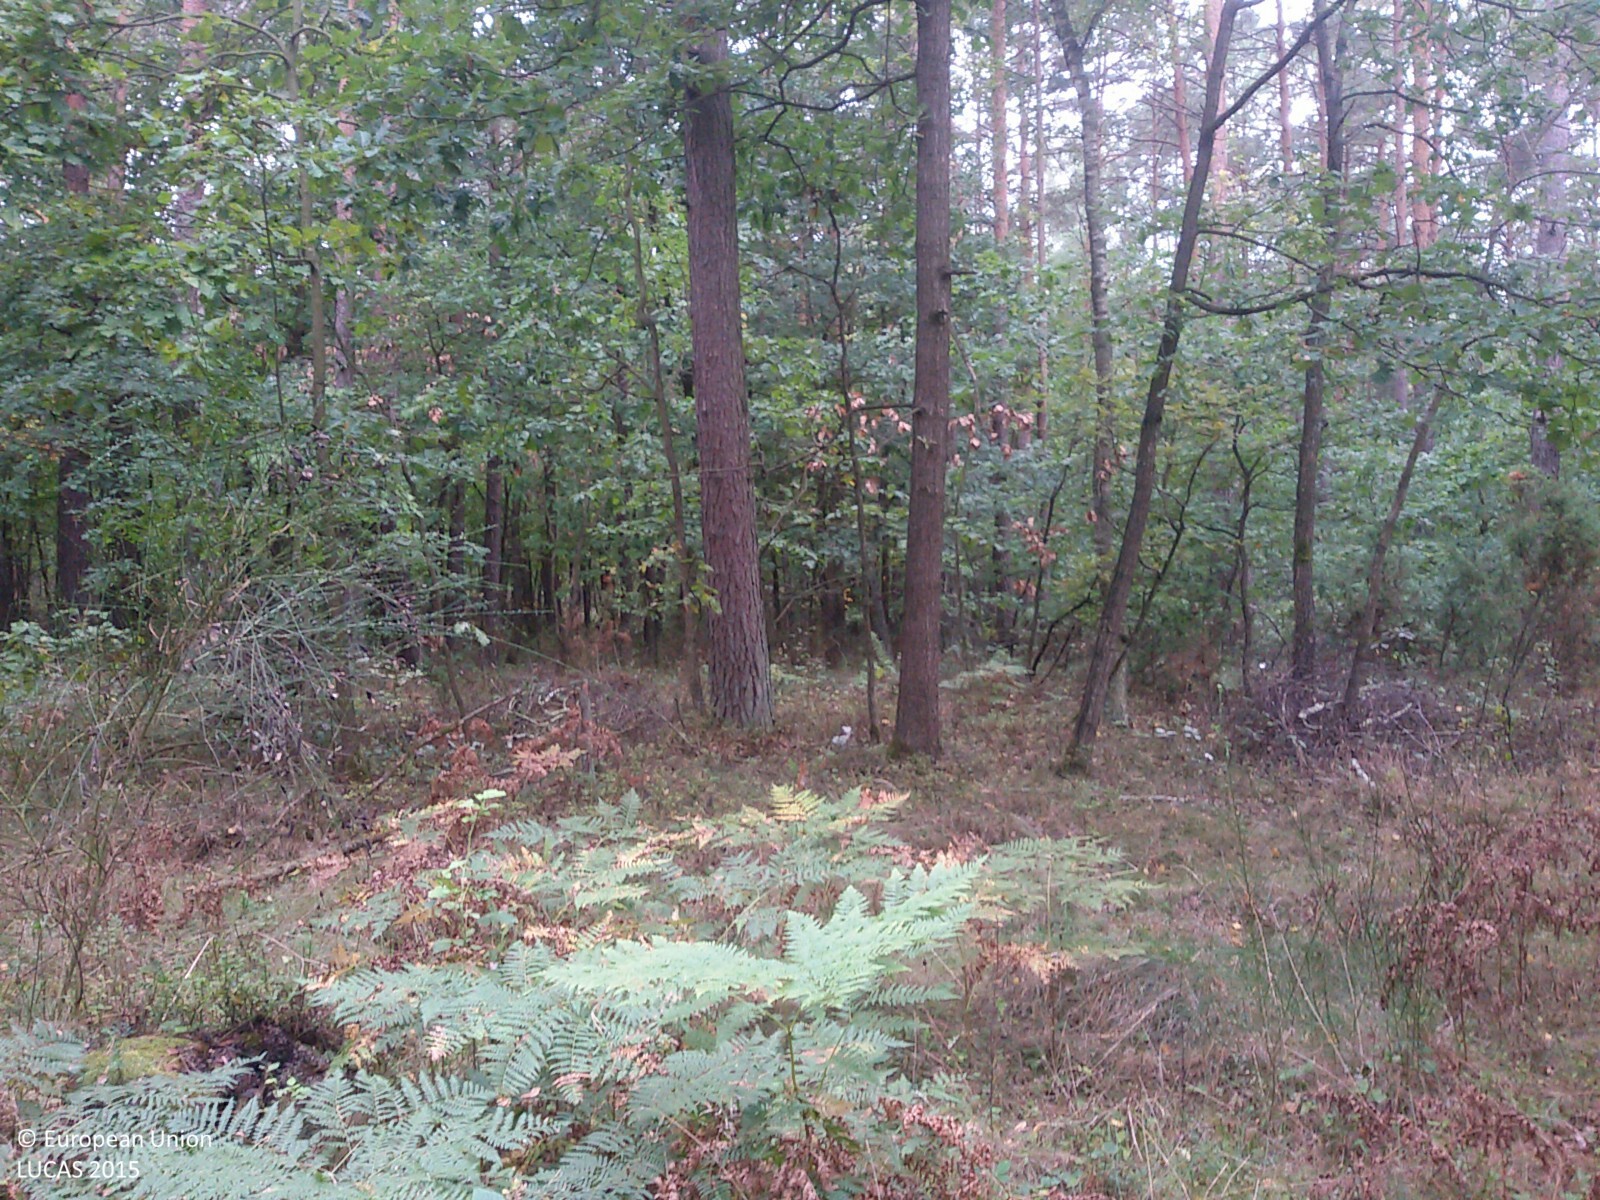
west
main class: Woodland
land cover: Pine dominated mixed woodland
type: hemiboreal forest and nemoral coniferous forest and mixed broadleaved-coniferous forest
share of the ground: > 75 %
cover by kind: coniferous forest trees 70 %, broadleaved forest trees 25 %, herbaceous plants 5 %
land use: Forestry
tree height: > 5 m
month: September
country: PL
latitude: 51.1627
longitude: 18.8163
